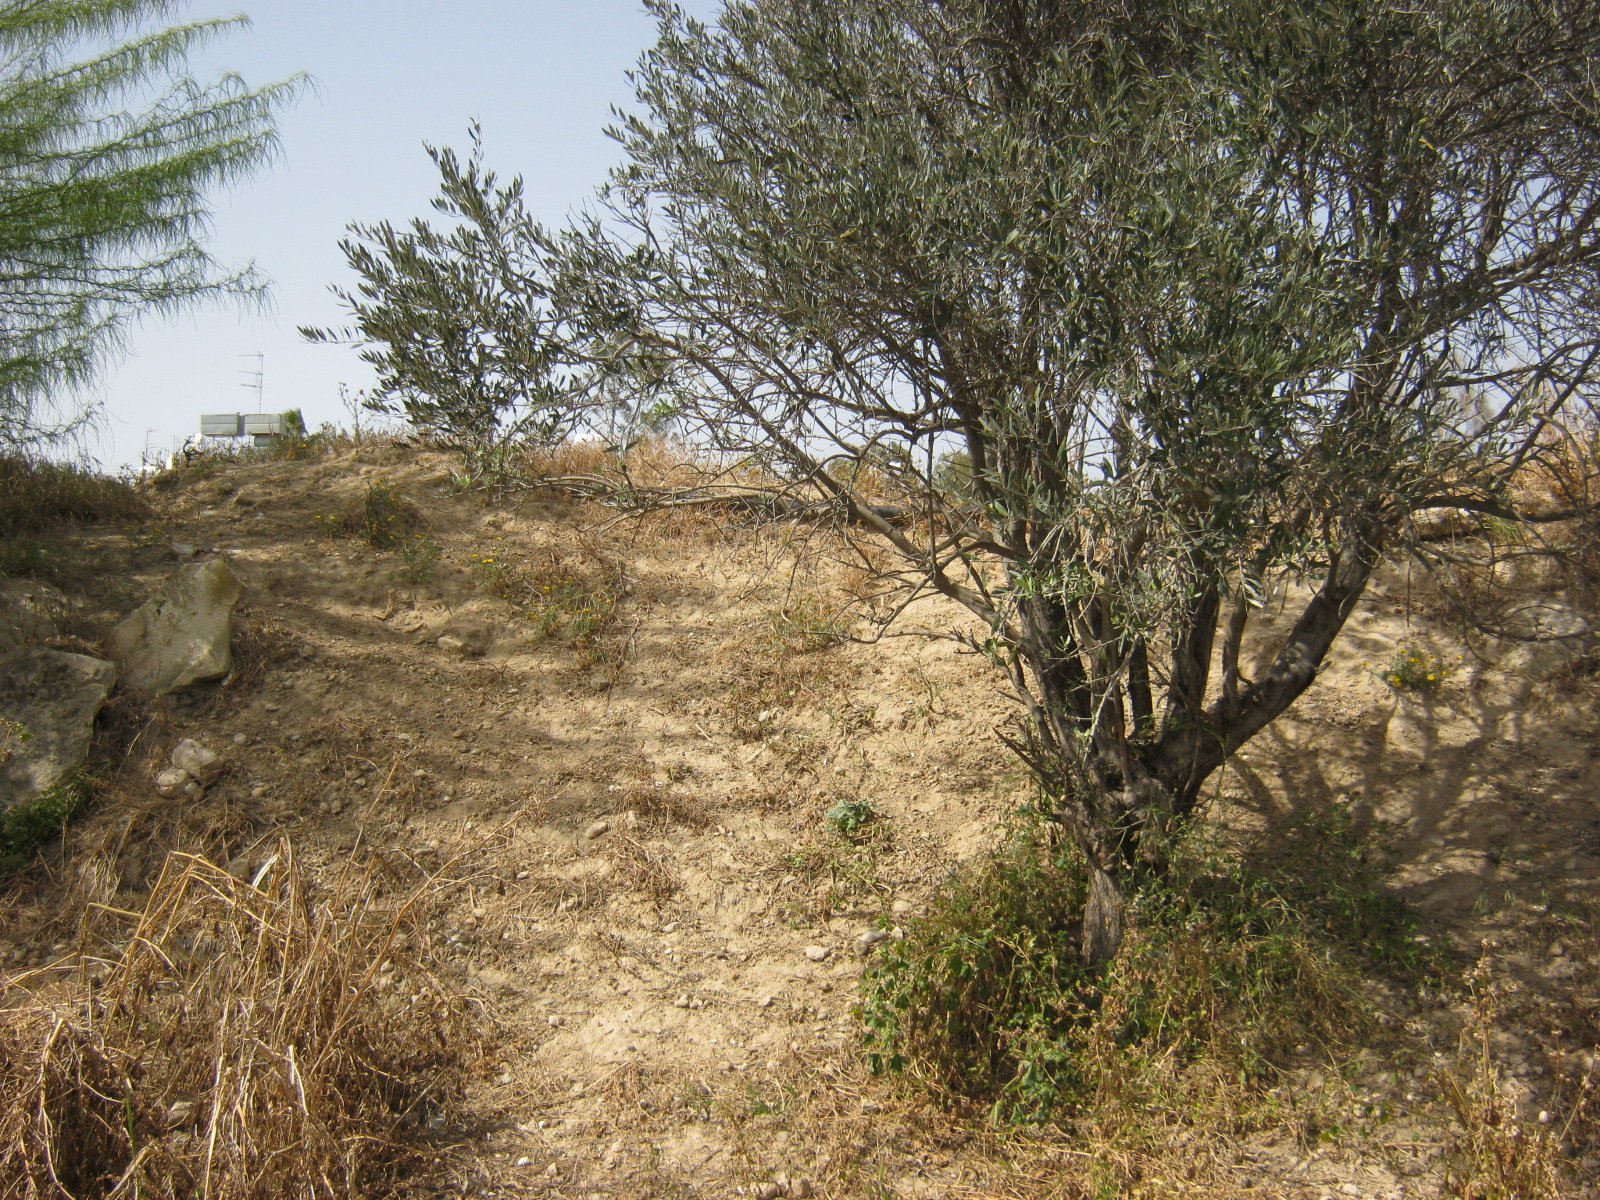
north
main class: Grassland
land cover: Spontaneously vegetated surfaces
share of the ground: > 75 %
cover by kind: herbaceous plants 100 %
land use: Semi-natural and natural areas not in use
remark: Temporary dry
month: April
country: CY
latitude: 35.0991
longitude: 33.4174
